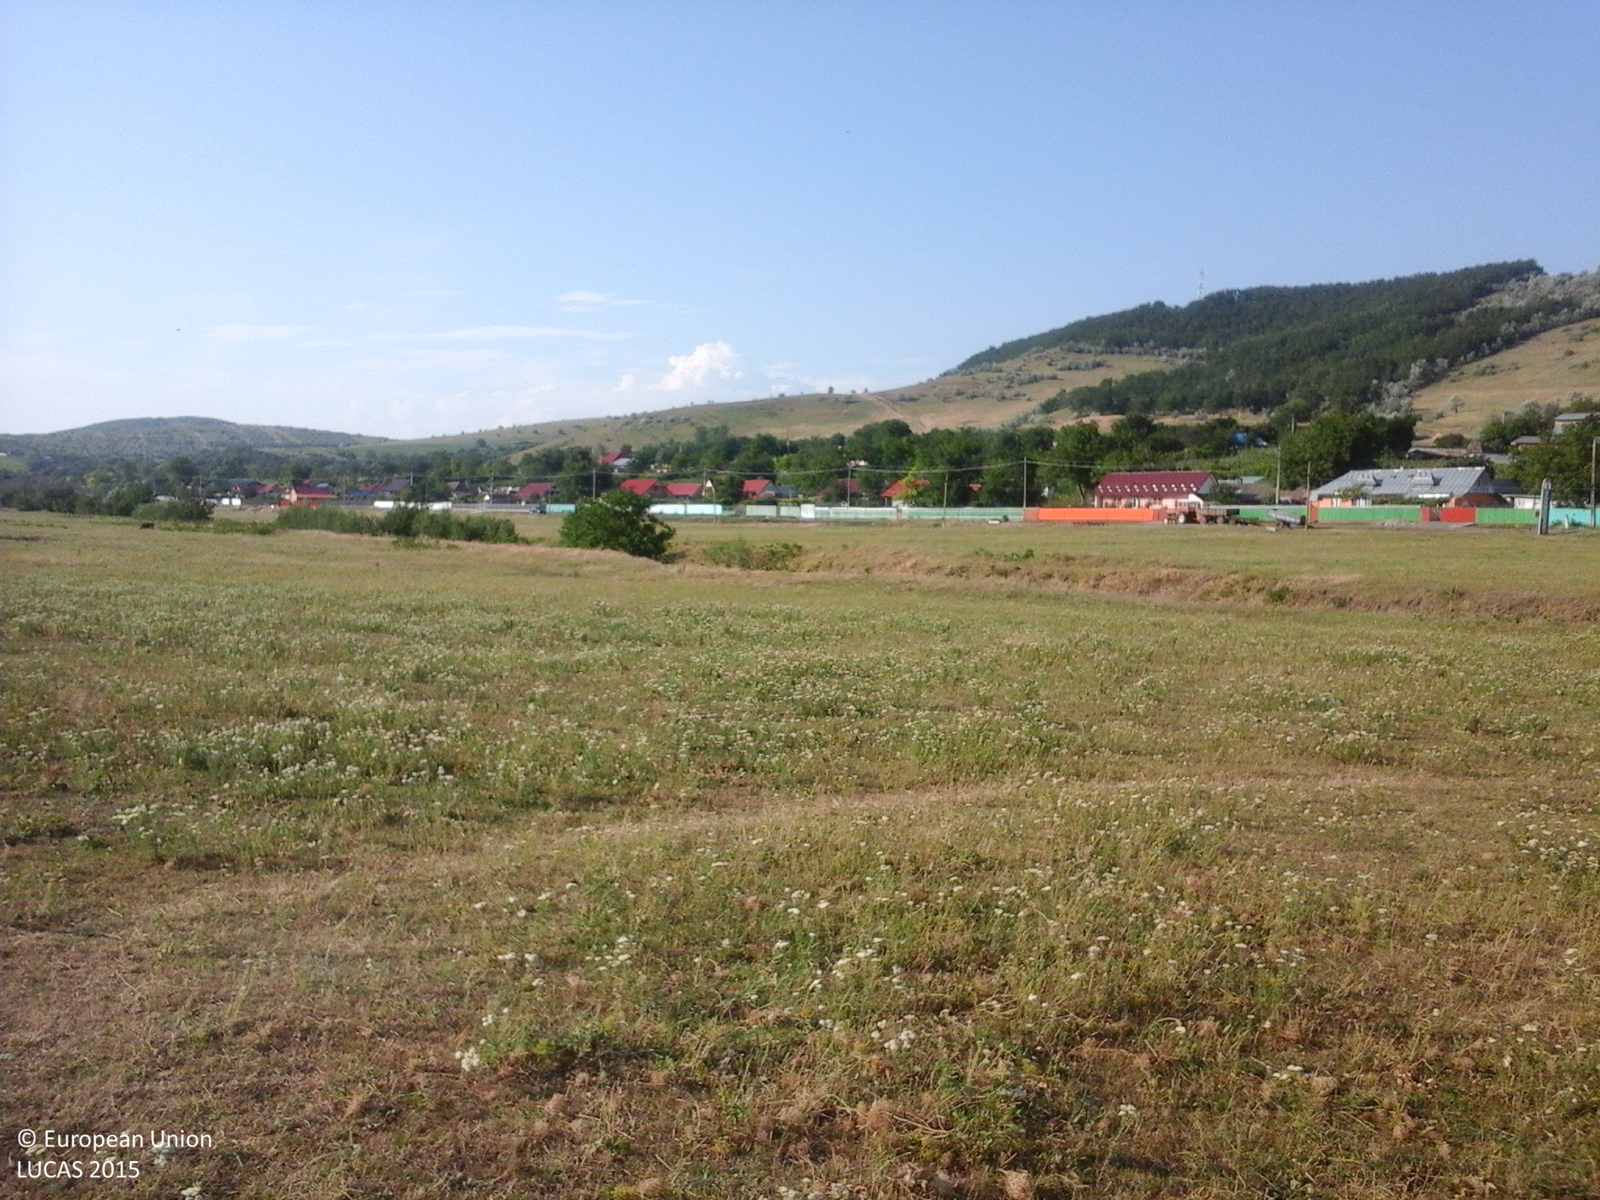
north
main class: Grassland
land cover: Grassland without tree/shrub cover
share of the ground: > 75 %
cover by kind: herbaceous plants 95 %, shrubs 5 %
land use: Agriculture (excluding fallow land and kitchen gardens)
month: June
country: RO
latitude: 46.7792
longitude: 27.8986
